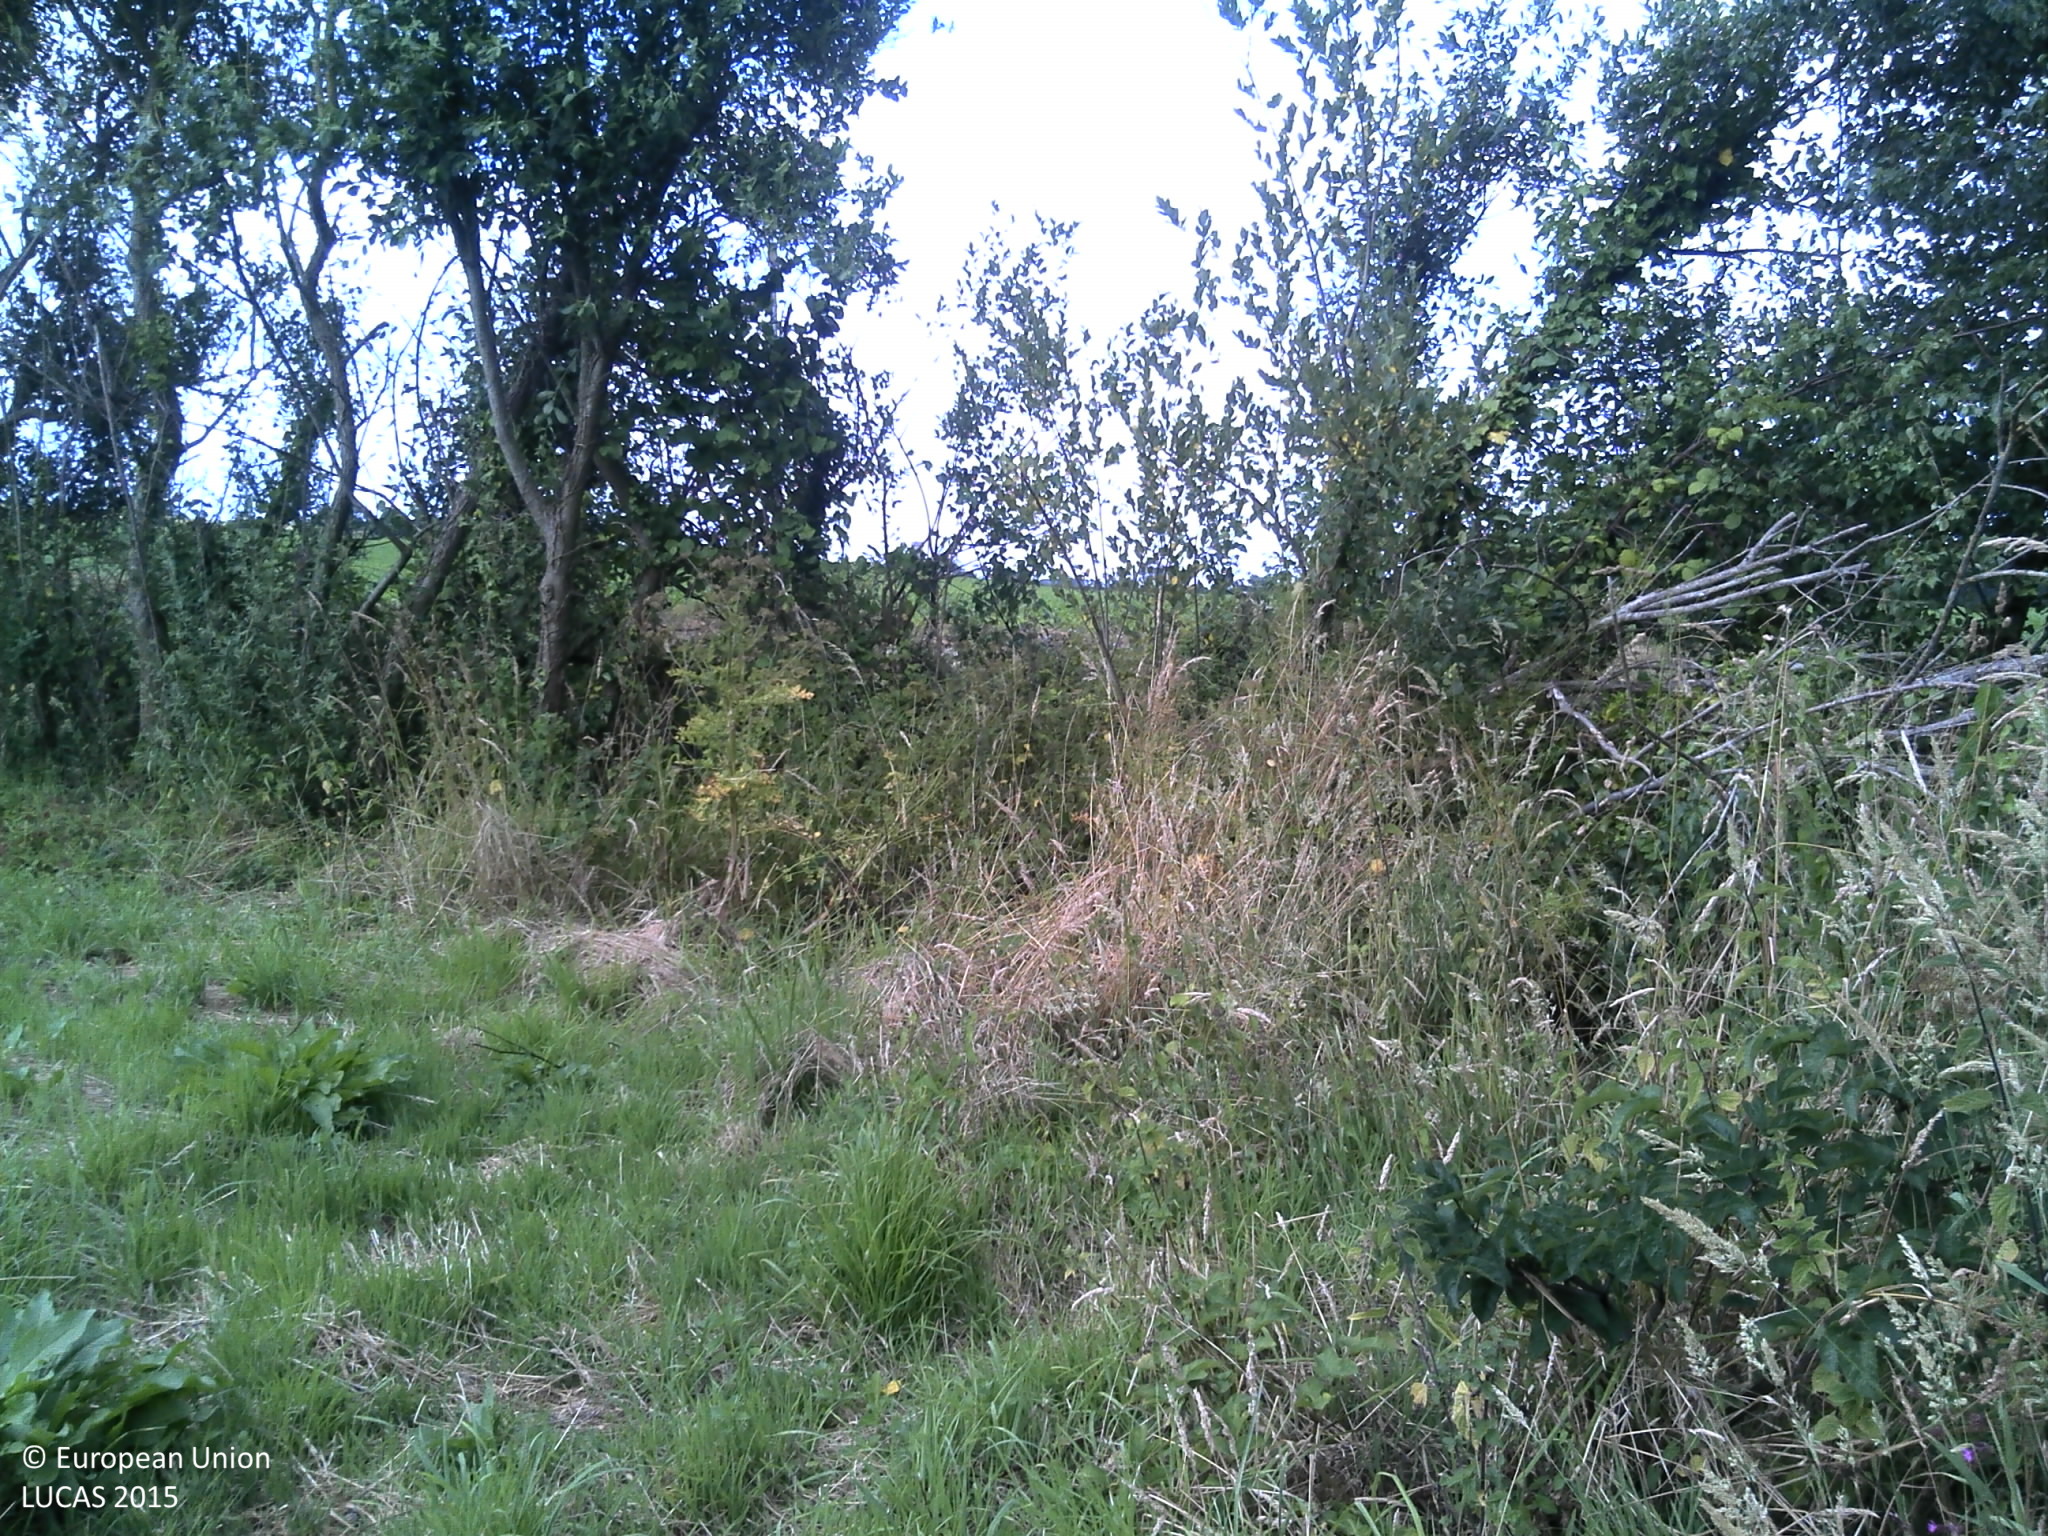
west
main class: Woodland
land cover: Broadleaved woodland
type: acidophilous oak and oak-birch forest
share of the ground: > 75 %
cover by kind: broadleaved forest trees 90 %, shrubs 5 %, herbaceous plants 5 %
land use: Agriculture (excluding fallow land and kitchen gardens)
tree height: > 5 m
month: July
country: FR
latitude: 48.1544
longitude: -4.2197
